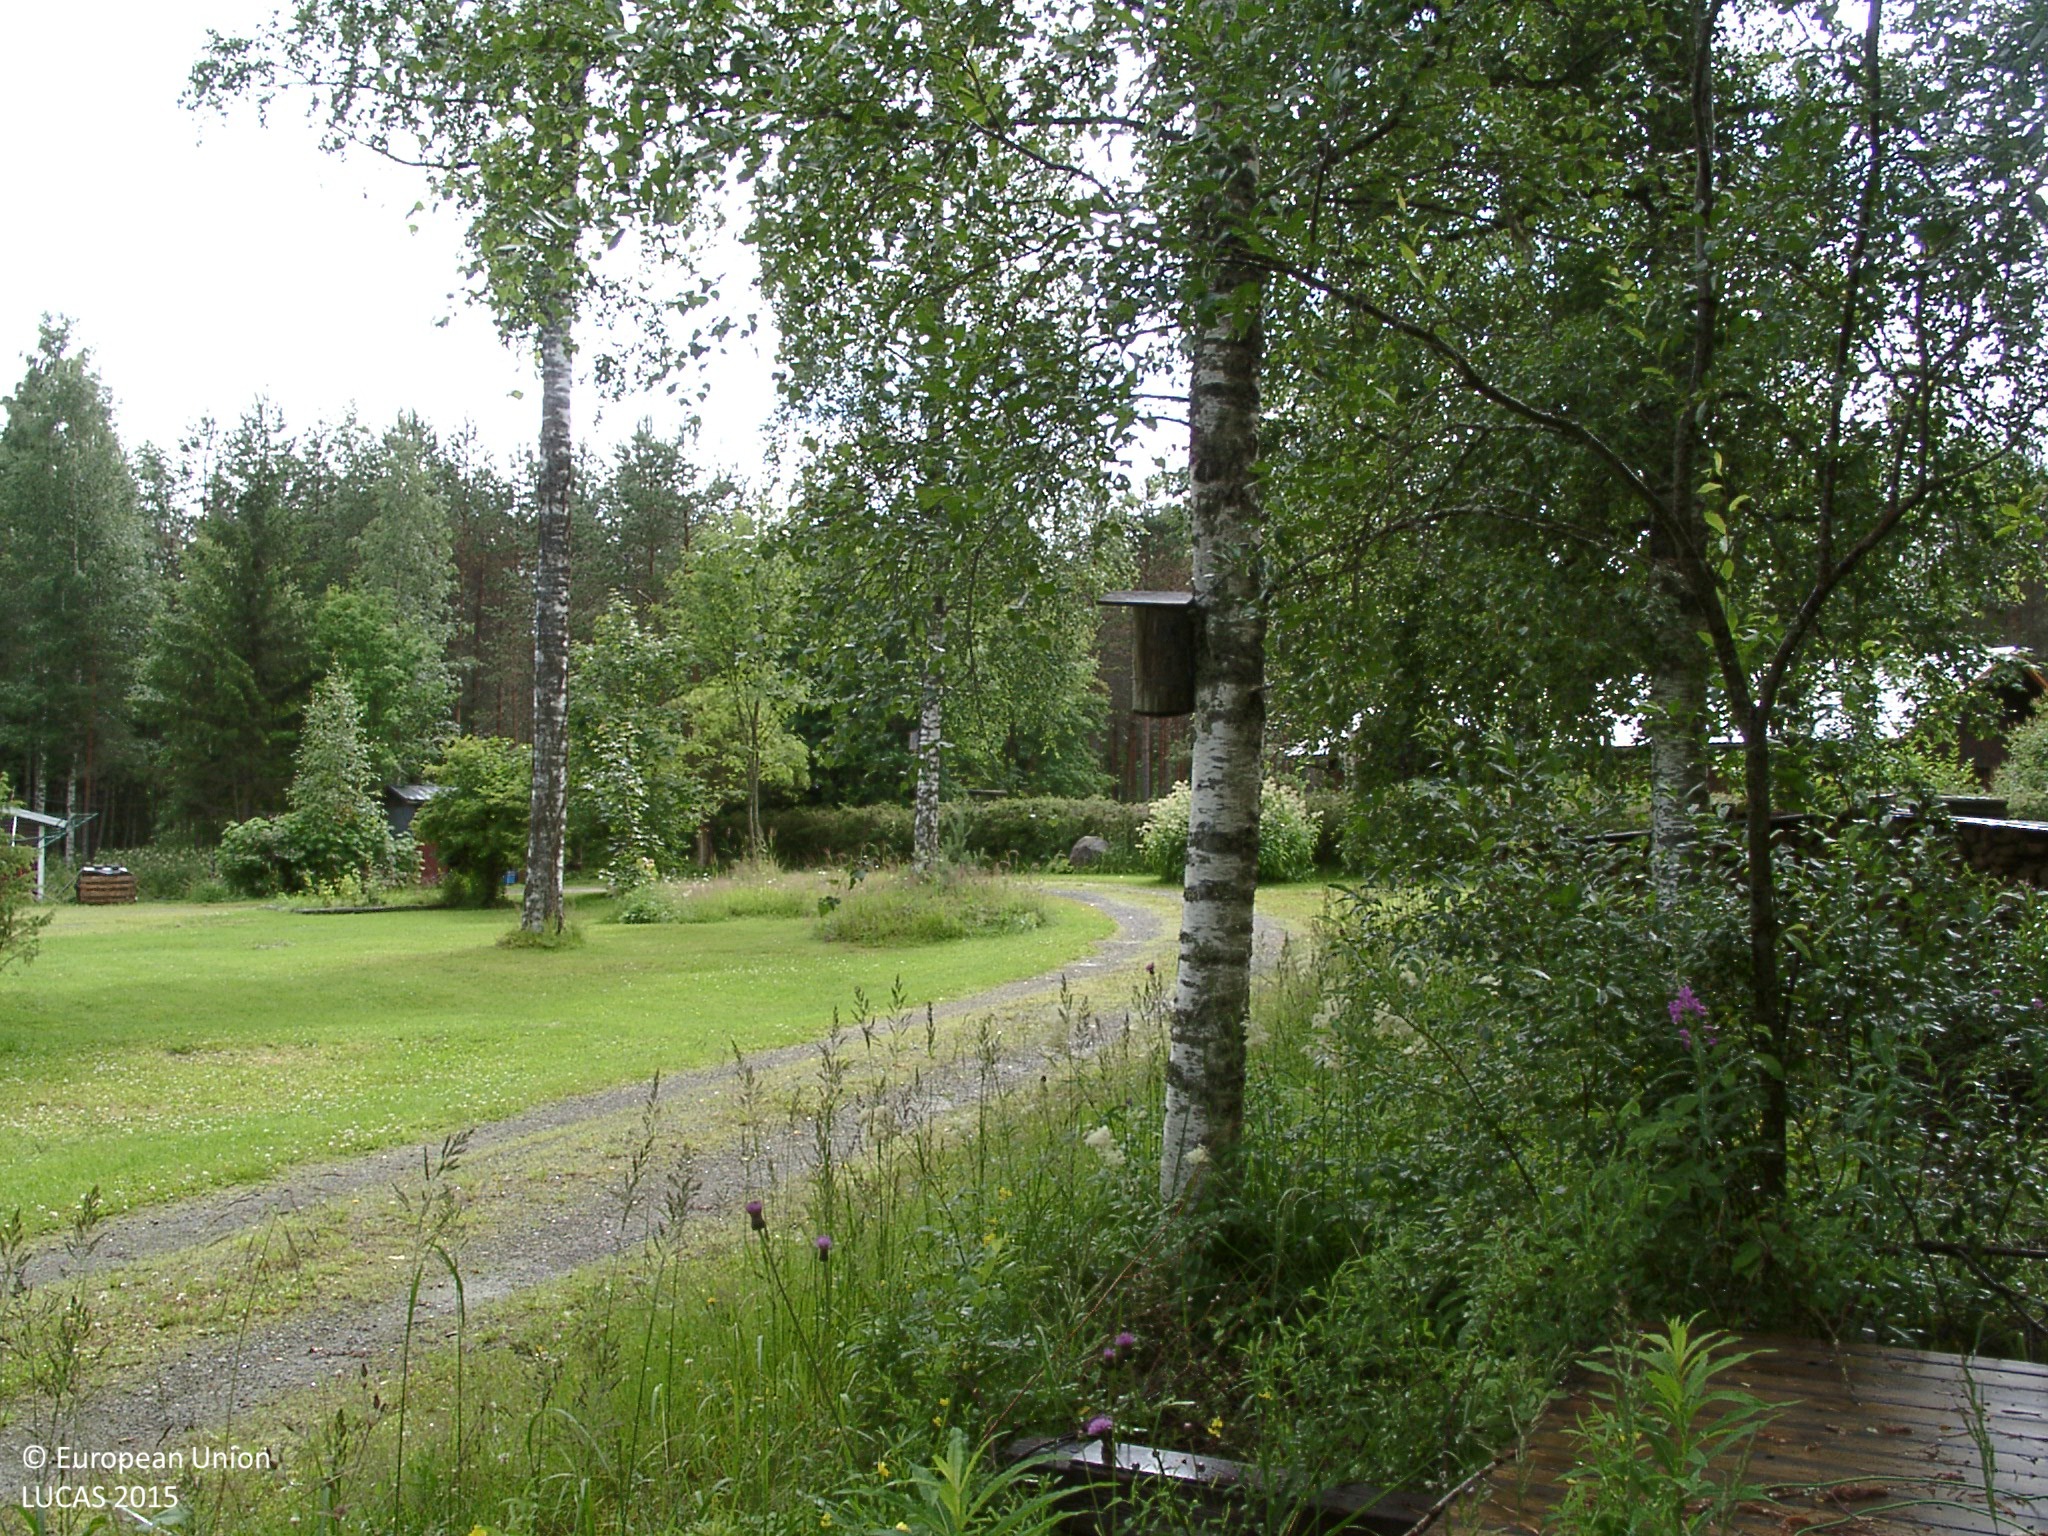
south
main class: Woodland
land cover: Broadleaved woodland
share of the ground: 25 - 50 %
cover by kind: broadleaved forest trees 35 %, herbaceous plants 30 %, coniferous forest trees 10 %, shrubs 10 %
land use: Residential
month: July
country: FI
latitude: 62.2845
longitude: 25.1192
